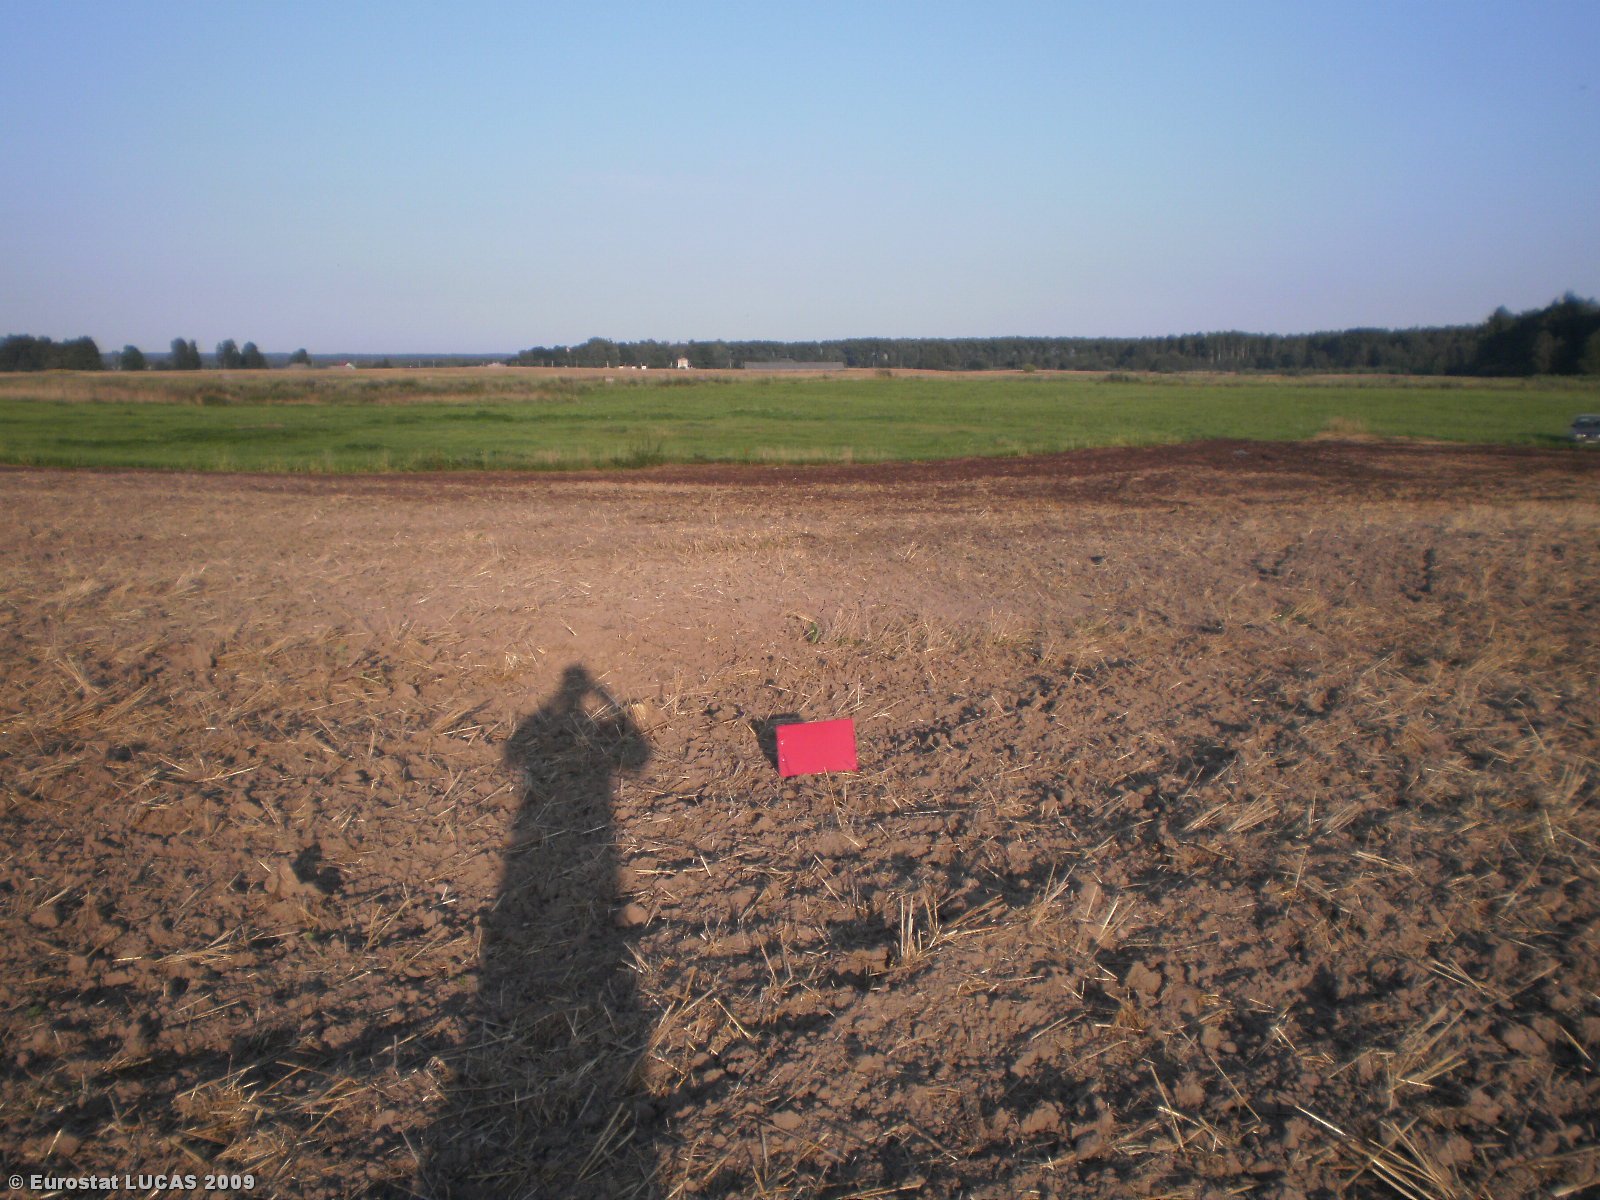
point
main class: Cropland
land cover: Common wheat
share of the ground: < 10 %
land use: Agriculture (excluding fallow land and kitchen gardens)
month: August
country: LT
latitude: 55.4680
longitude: 24.9640
